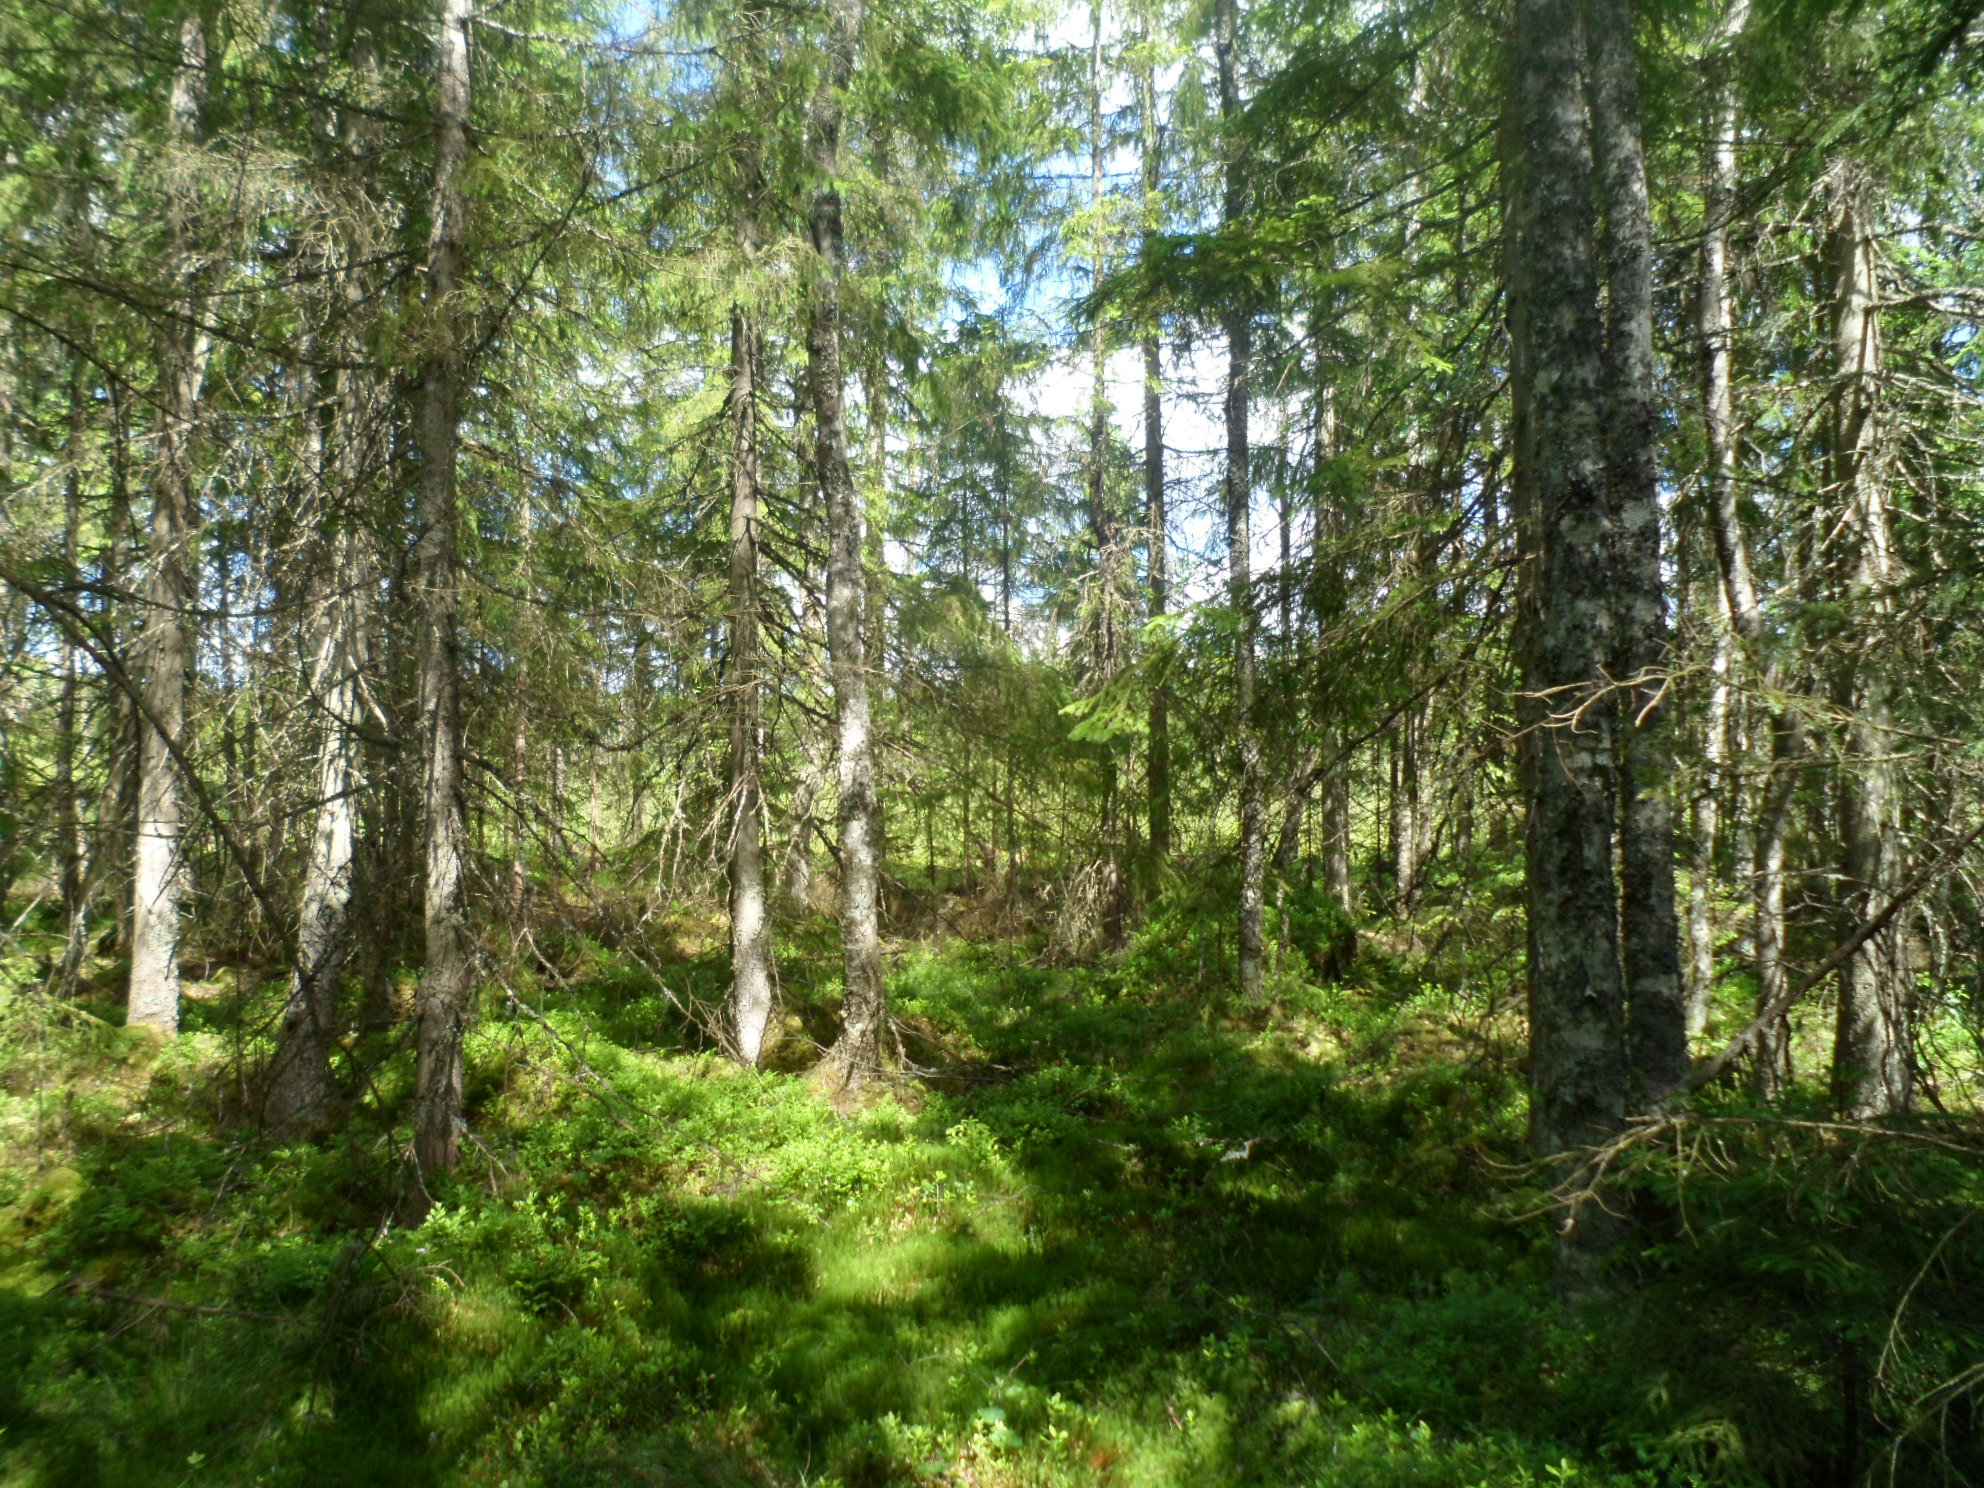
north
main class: Woodland
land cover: Spruce dominated coniferous woodland
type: boreal forest
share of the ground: 50 - 75 %
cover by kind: coniferous forest trees 65 %, shrubs 15 %, broadleaved forest trees 10 %, lichens and mosses 10 %
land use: Forestry
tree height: > 5 m
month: July
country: SE
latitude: 57.4065
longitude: 14.4732
